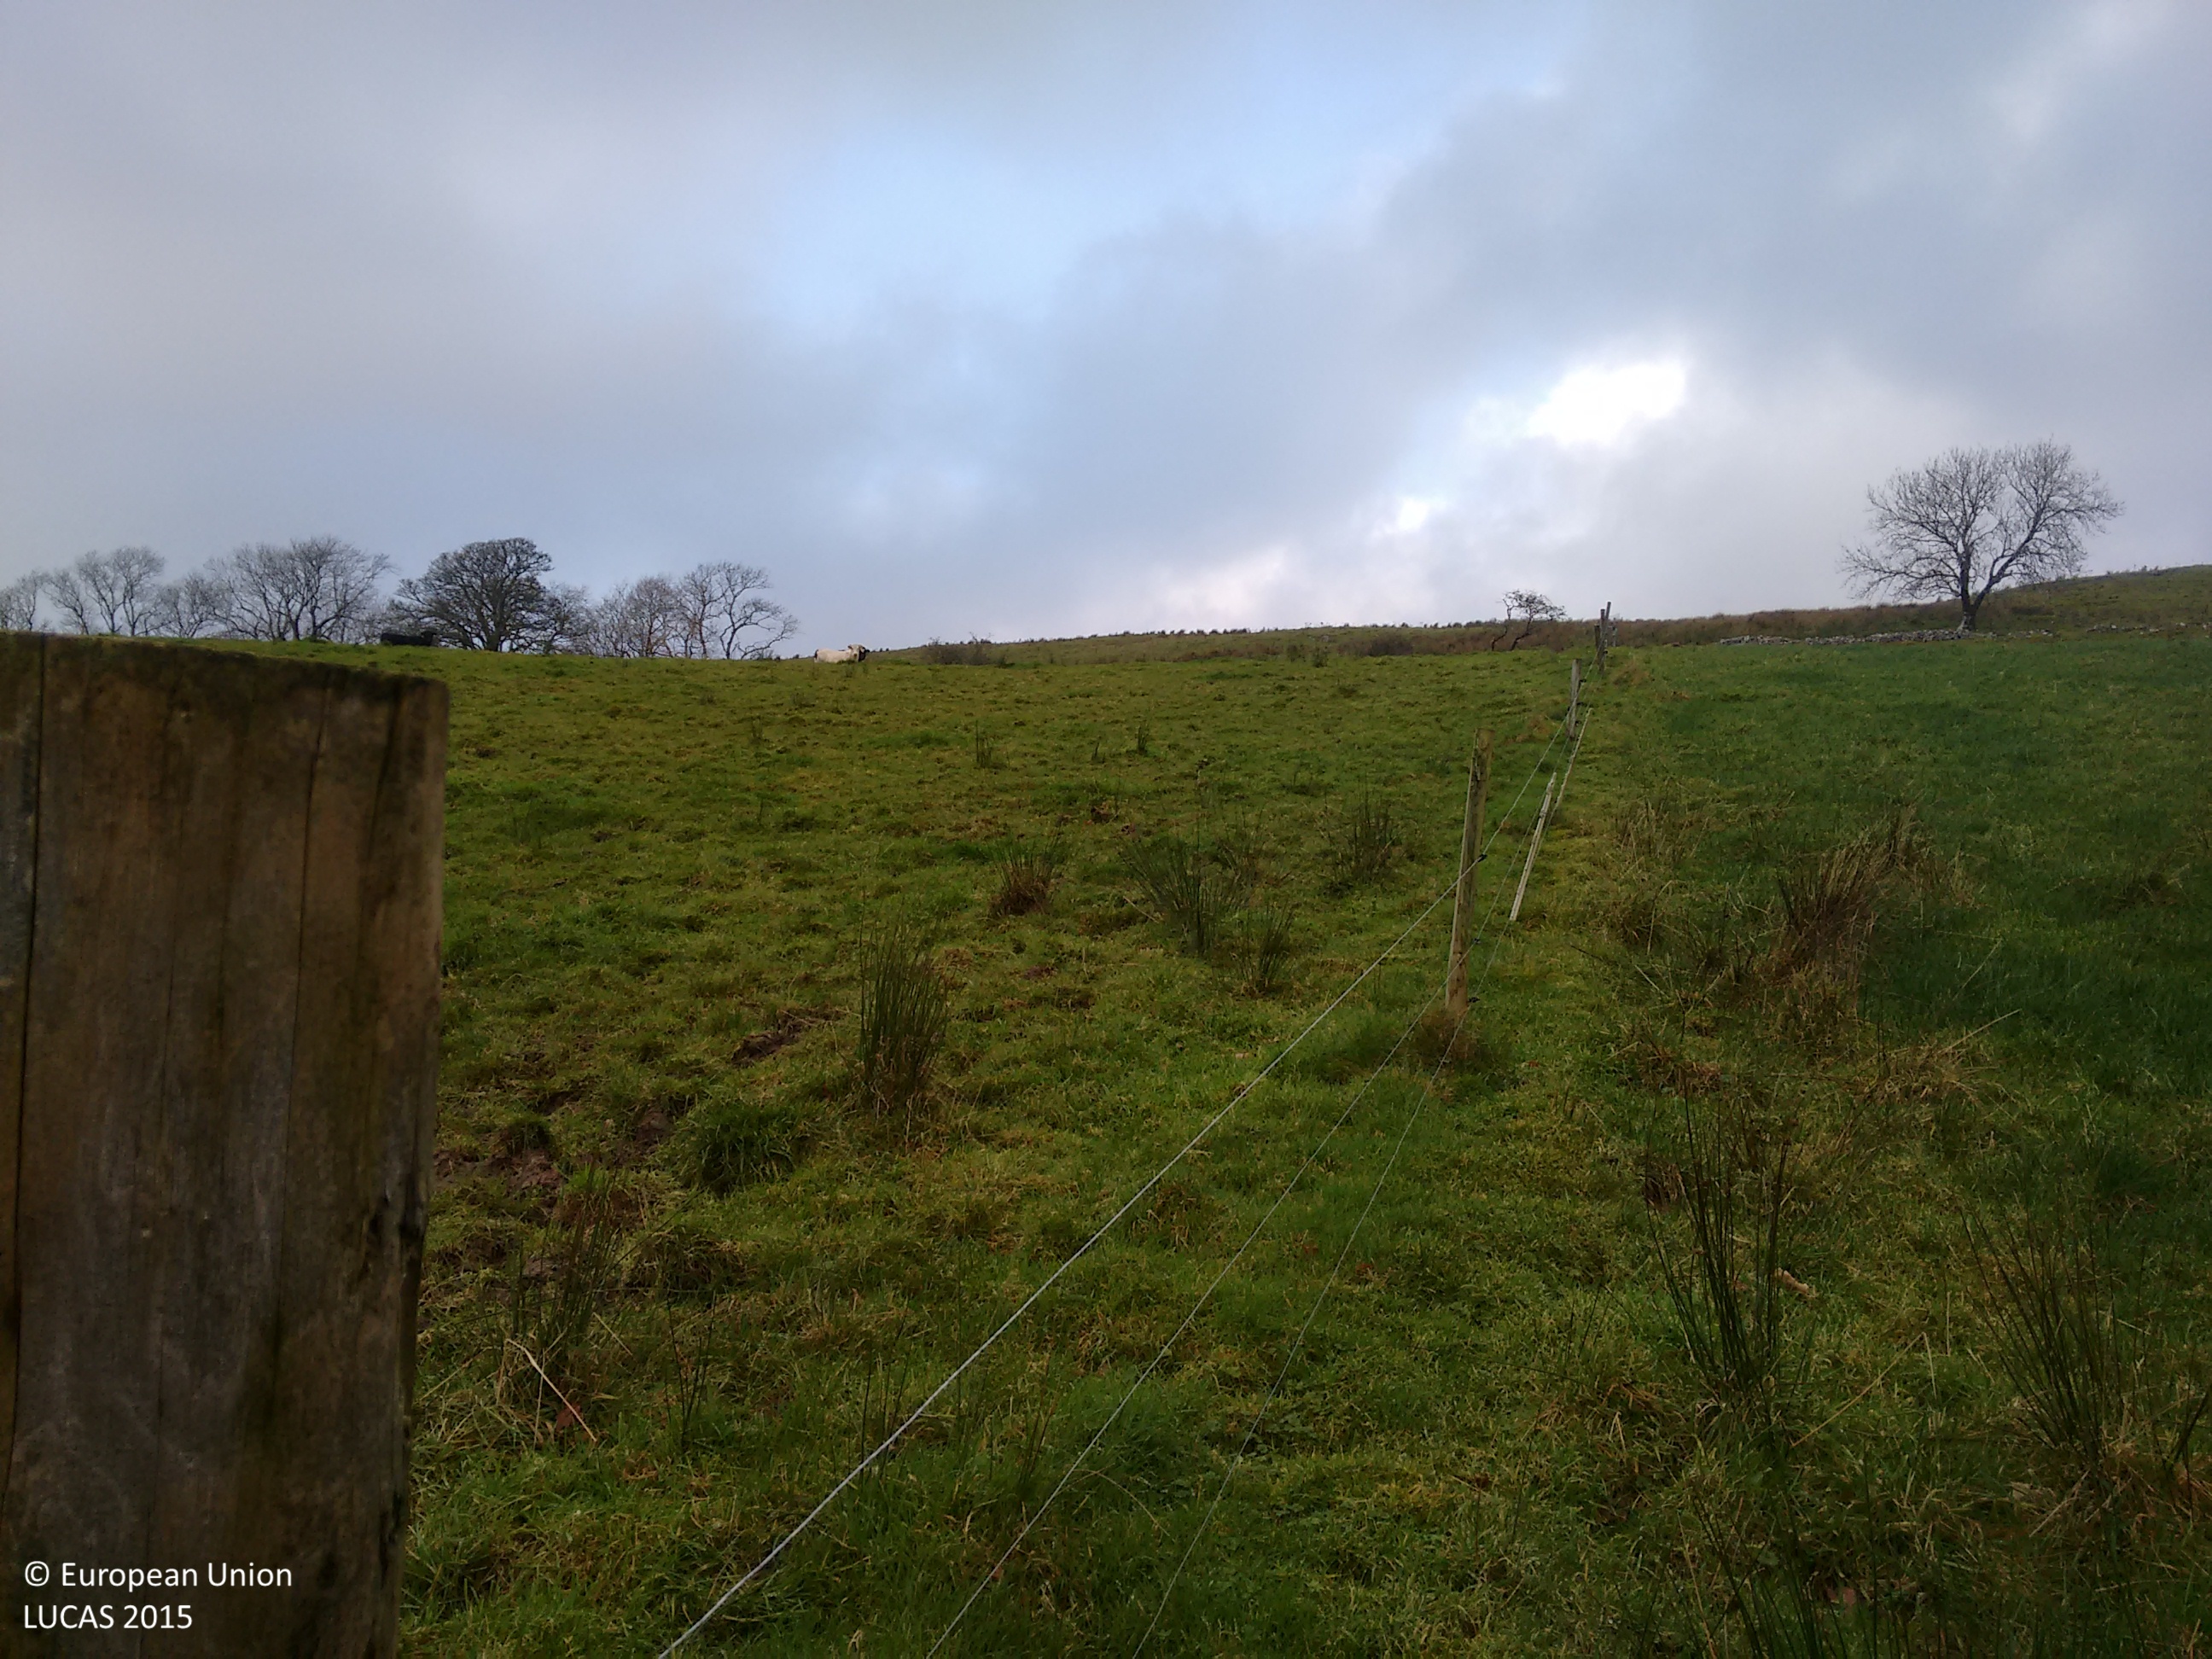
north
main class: Grassland
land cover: Grassland without tree/shrub cover
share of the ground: > 75 %
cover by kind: herbaceous plants 100 %
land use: Agriculture (excluding fallow land and kitchen gardens)
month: November
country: IE
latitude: 54.2852
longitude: -8.3903
